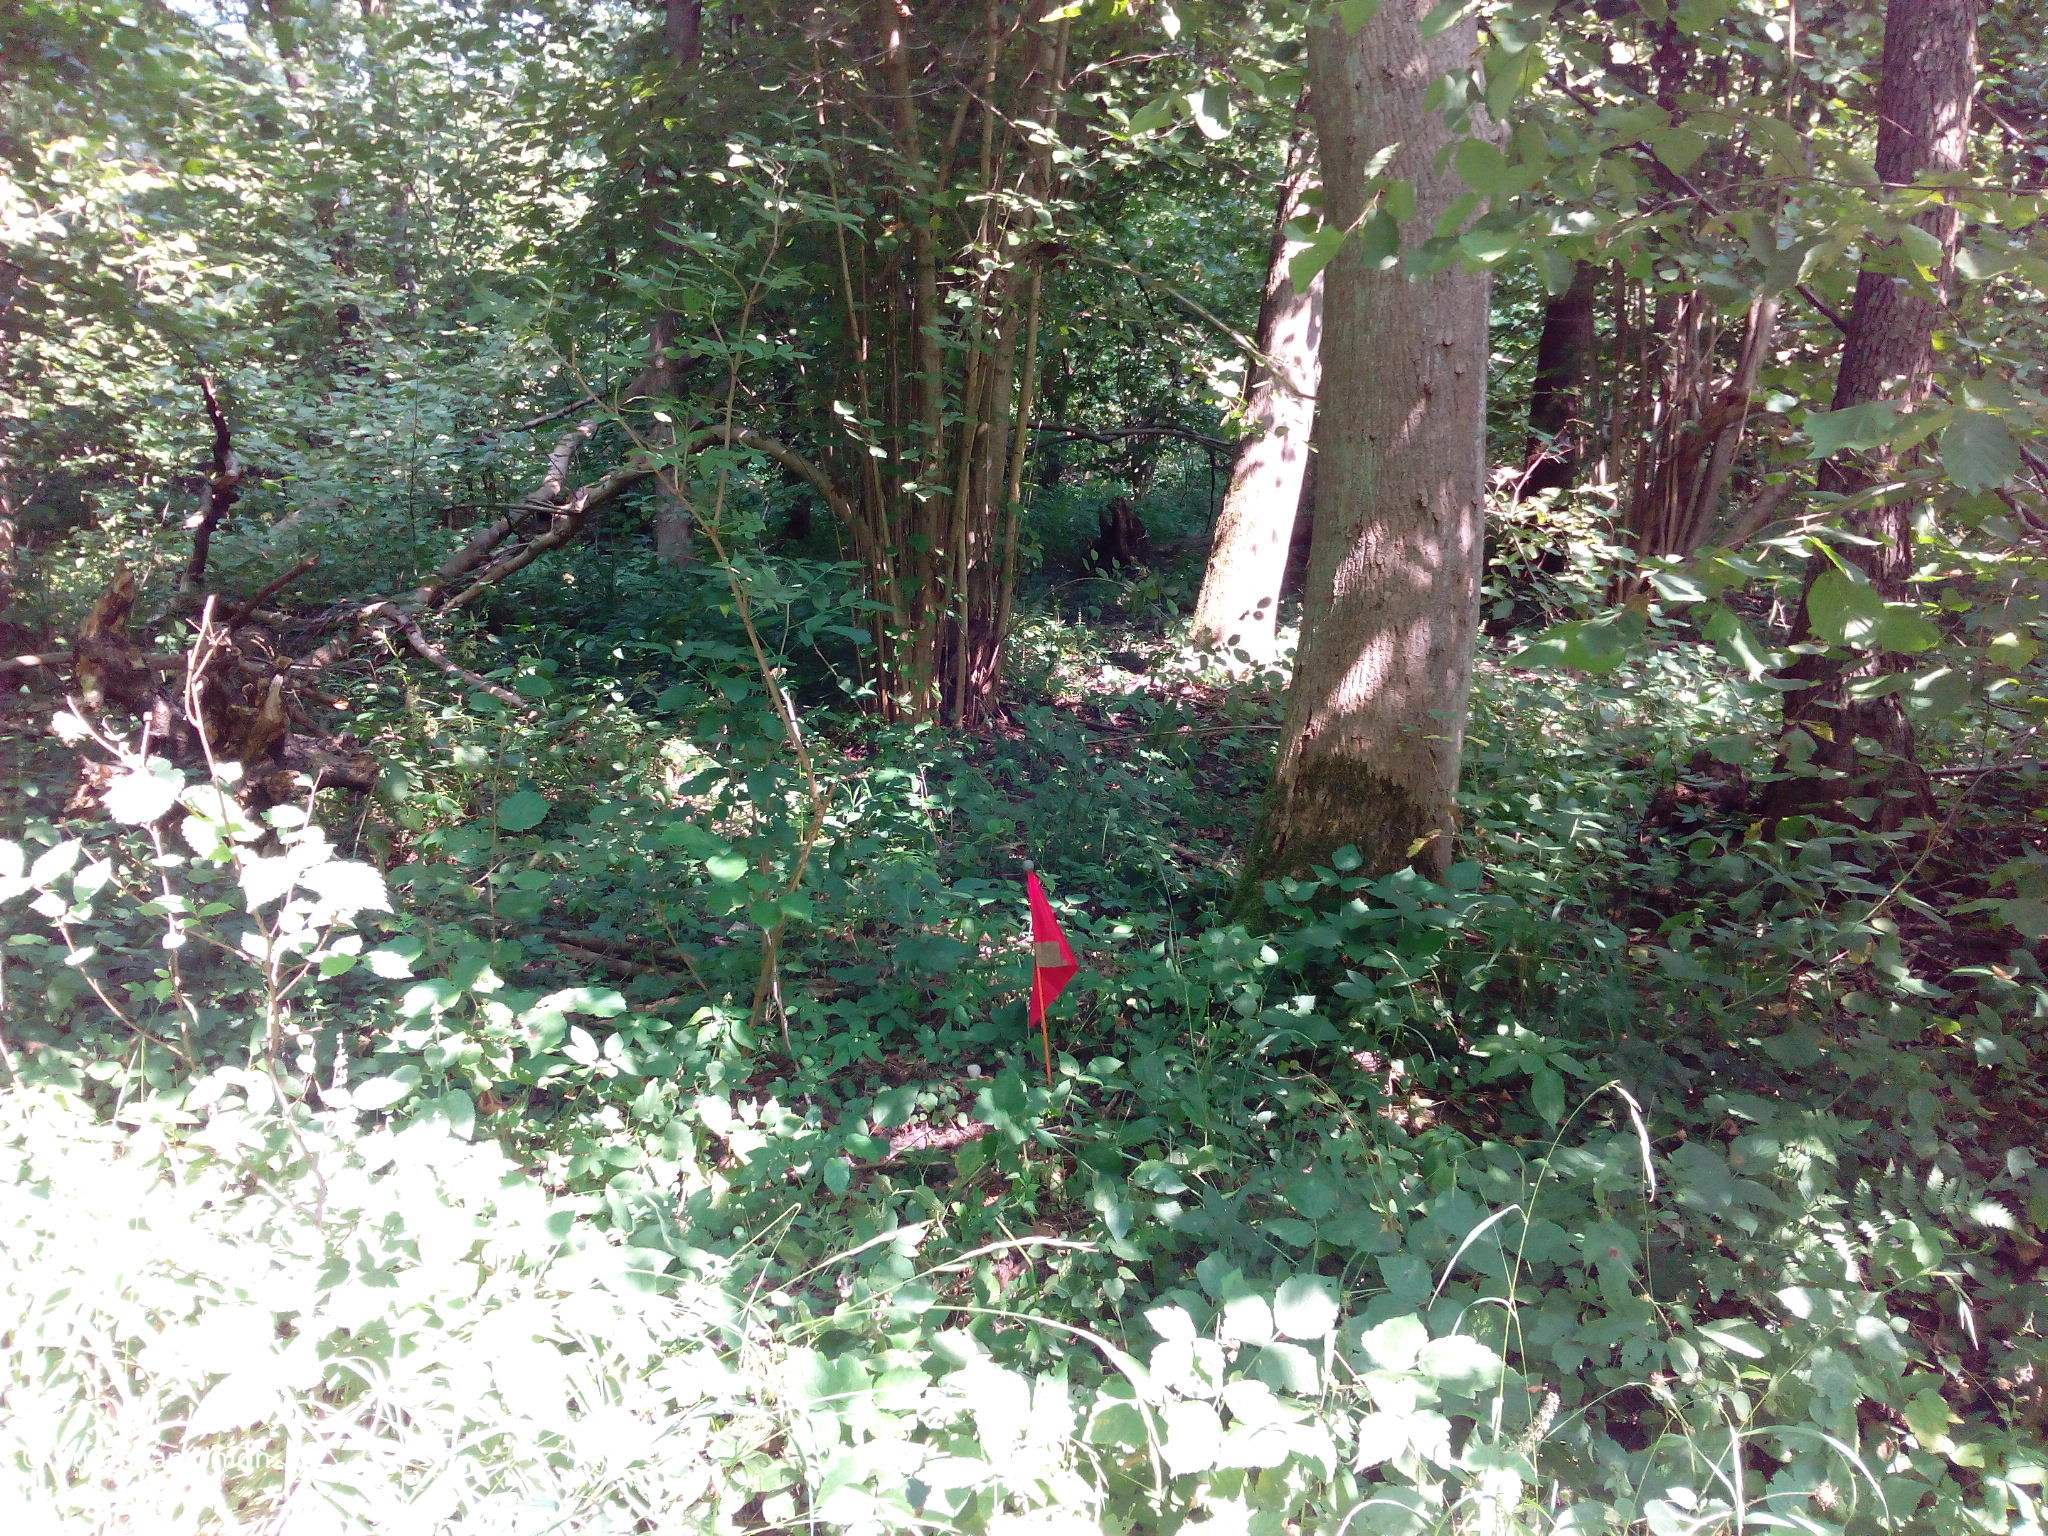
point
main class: Woodland
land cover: Broadleaved woodland
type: mesophytic deciduous forest
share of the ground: > 75 %
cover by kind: broadleaved forest trees 70 %, herbaceous plants 20 %, shrubs 10 %
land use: Forestry
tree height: > 5 m
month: August
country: DE
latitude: 53.1111
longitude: 14.2585
